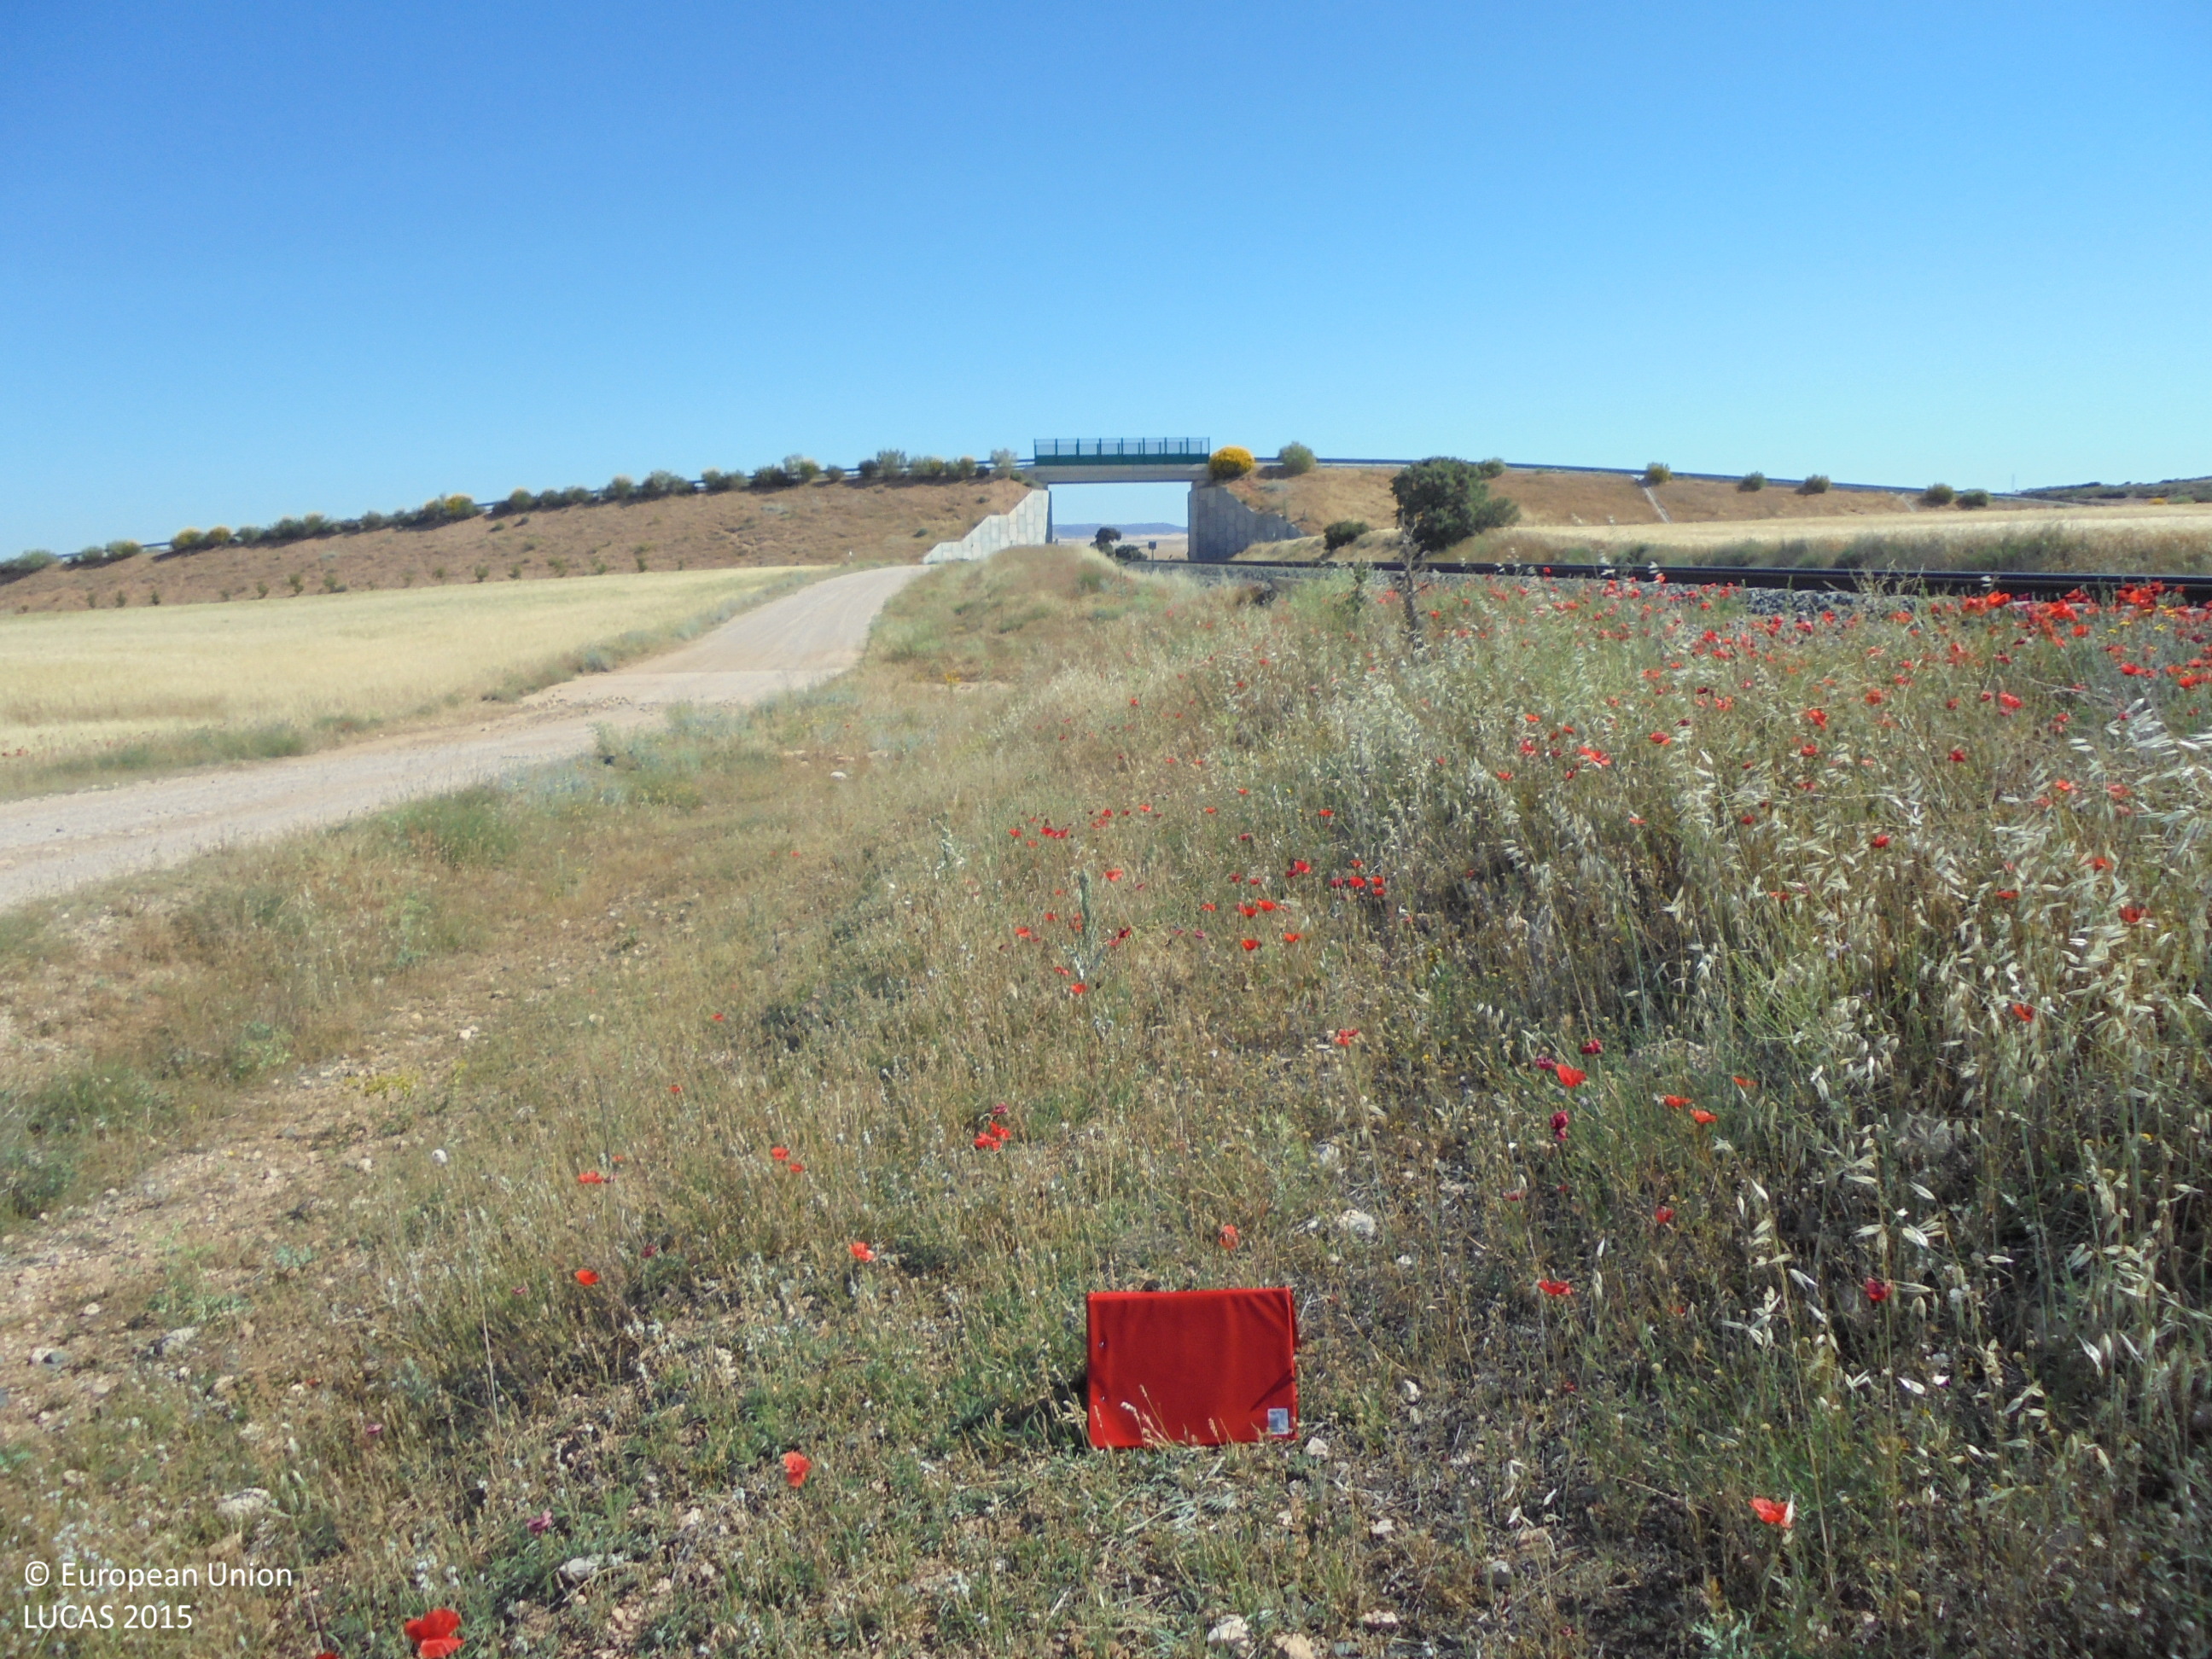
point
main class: Grassland
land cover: Grassland without tree/shrub cover
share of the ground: > 75 %
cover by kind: herbaceous plants 85 %, unconsolidated bare surface 15 %
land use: Semi-natural and natural areas not in use
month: June
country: ES
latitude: 38.8323
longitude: -1.7128
